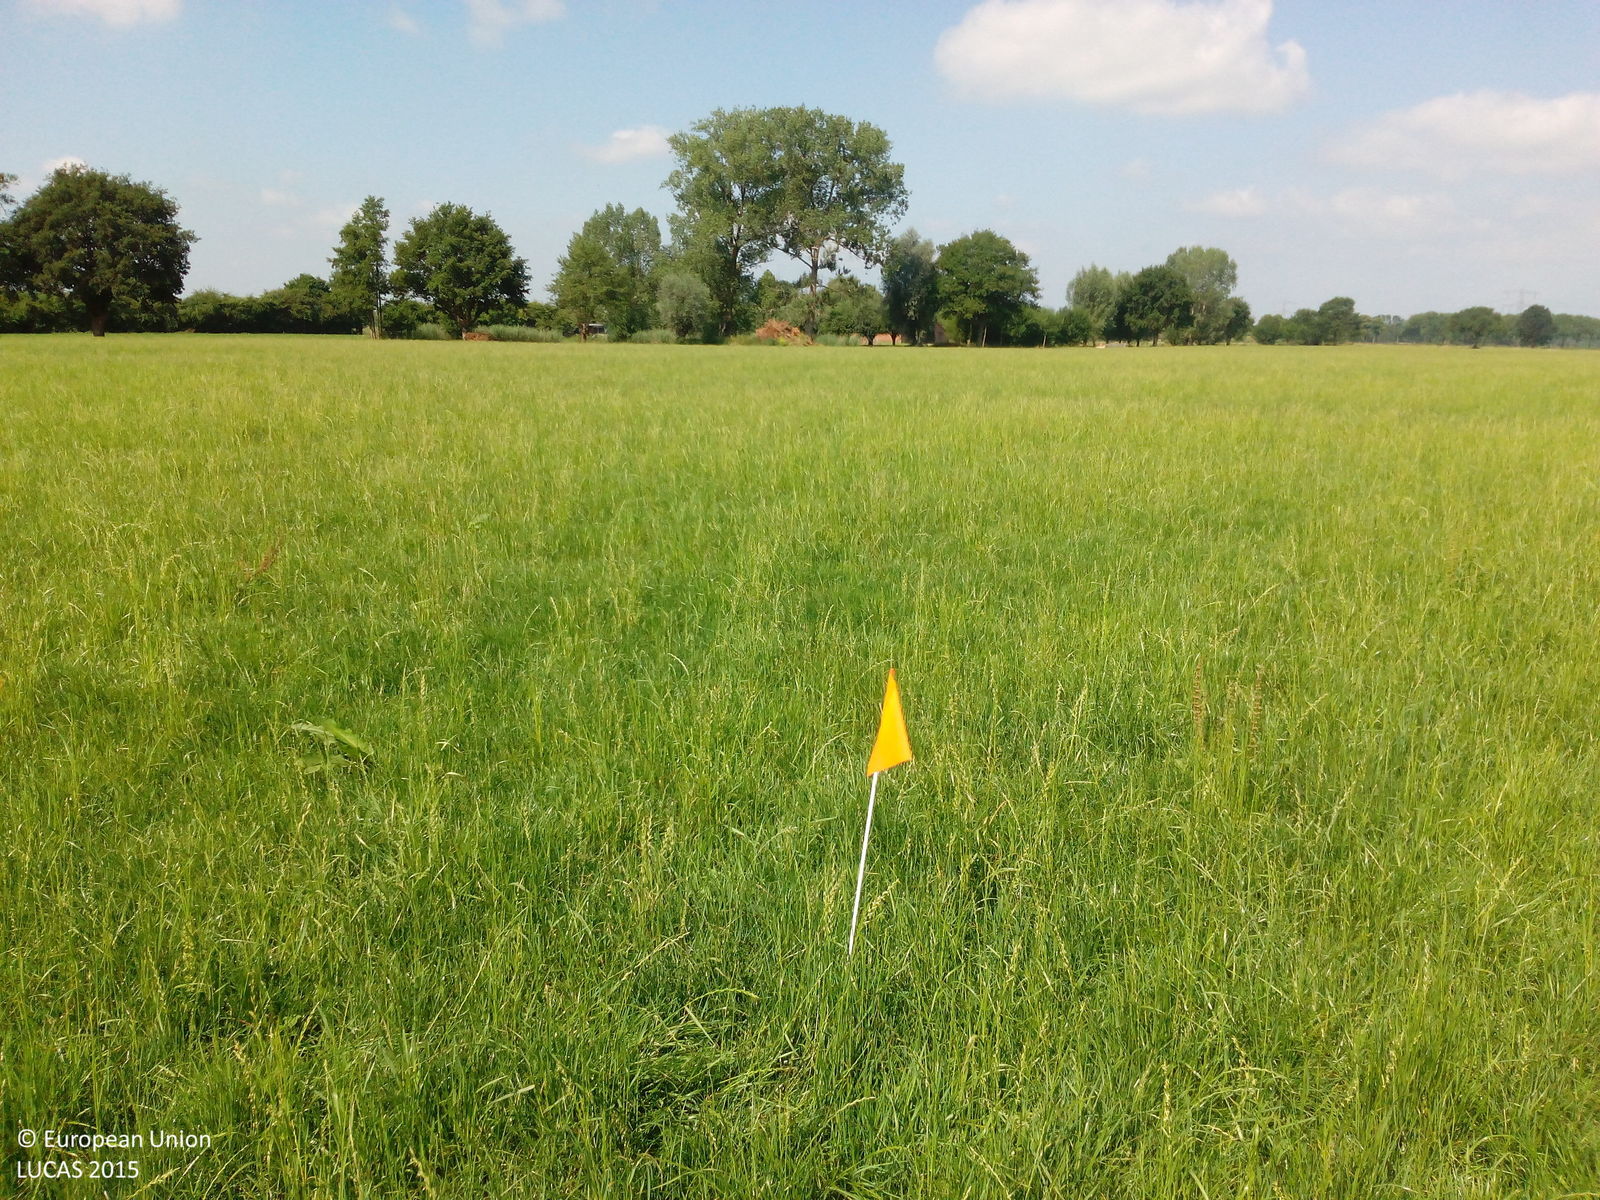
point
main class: Grassland
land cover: Grassland without tree/shrub cover
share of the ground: > 75 %
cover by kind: herbaceous plants 100 %
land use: Agriculture (excluding fallow land and kitchen gardens)
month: July
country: NL
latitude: 51.9757
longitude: 6.2289
